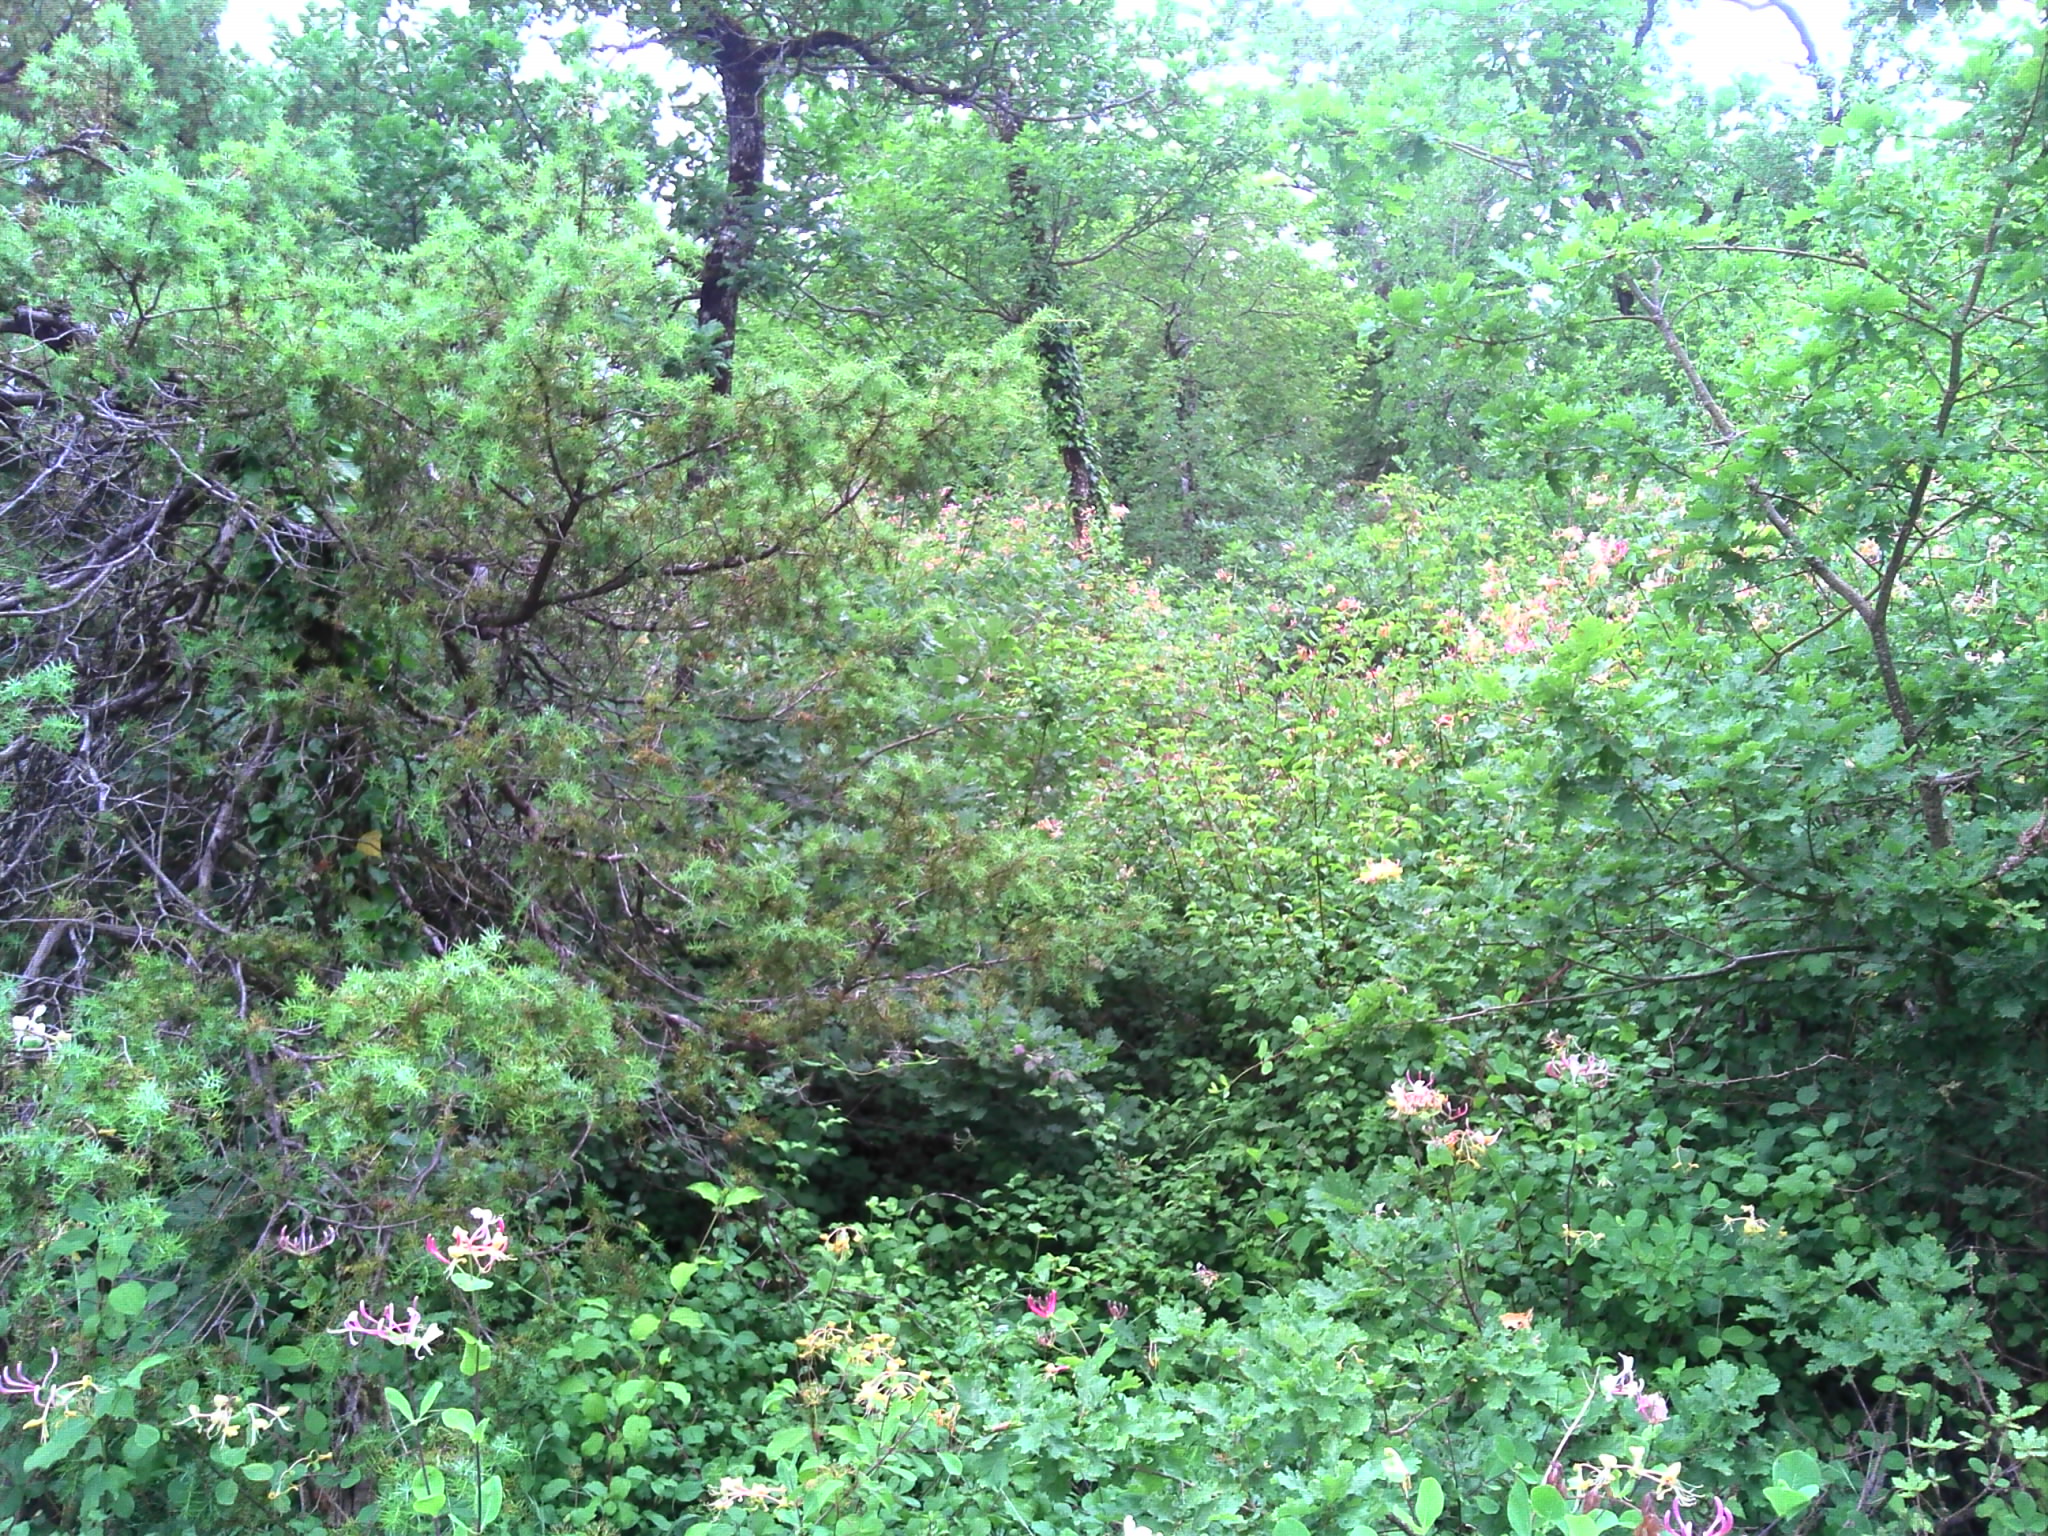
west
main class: Woodland
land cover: Broadleaved woodland
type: acidophilous oak and oak-birch forest
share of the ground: > 75 %
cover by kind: broadleaved forest trees 75 %, shrubs 20 %, herbaceous plants 5 %
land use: Forestry
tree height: > 5 m
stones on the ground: 25 - 50 %
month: June
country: FR
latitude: 44.4082
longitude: 1.8254
